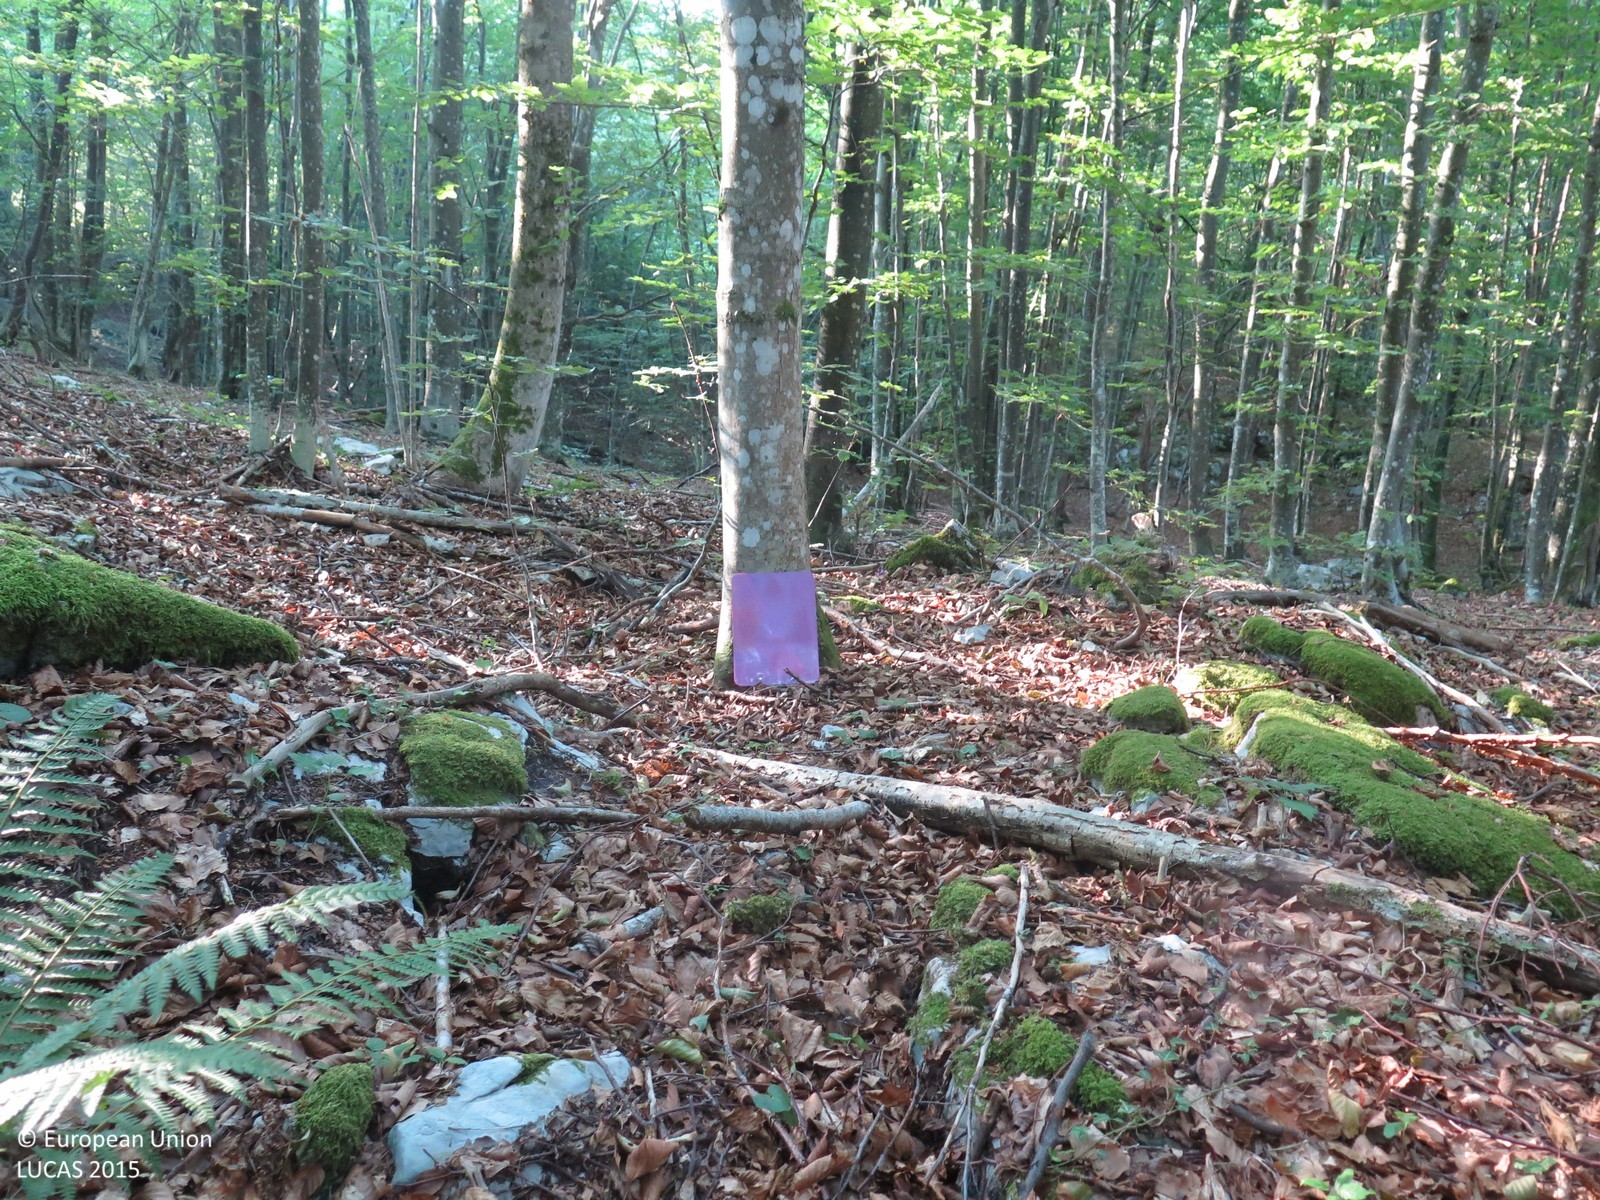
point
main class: Woodland
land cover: Broadleaved woodland
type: beech forest
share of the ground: > 75 %
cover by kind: broadleaved forest trees 95 %, lichens and mosses 5 %
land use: Forestry
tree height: > 5 m
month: August
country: HR
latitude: 45.4764
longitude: 14.9974
